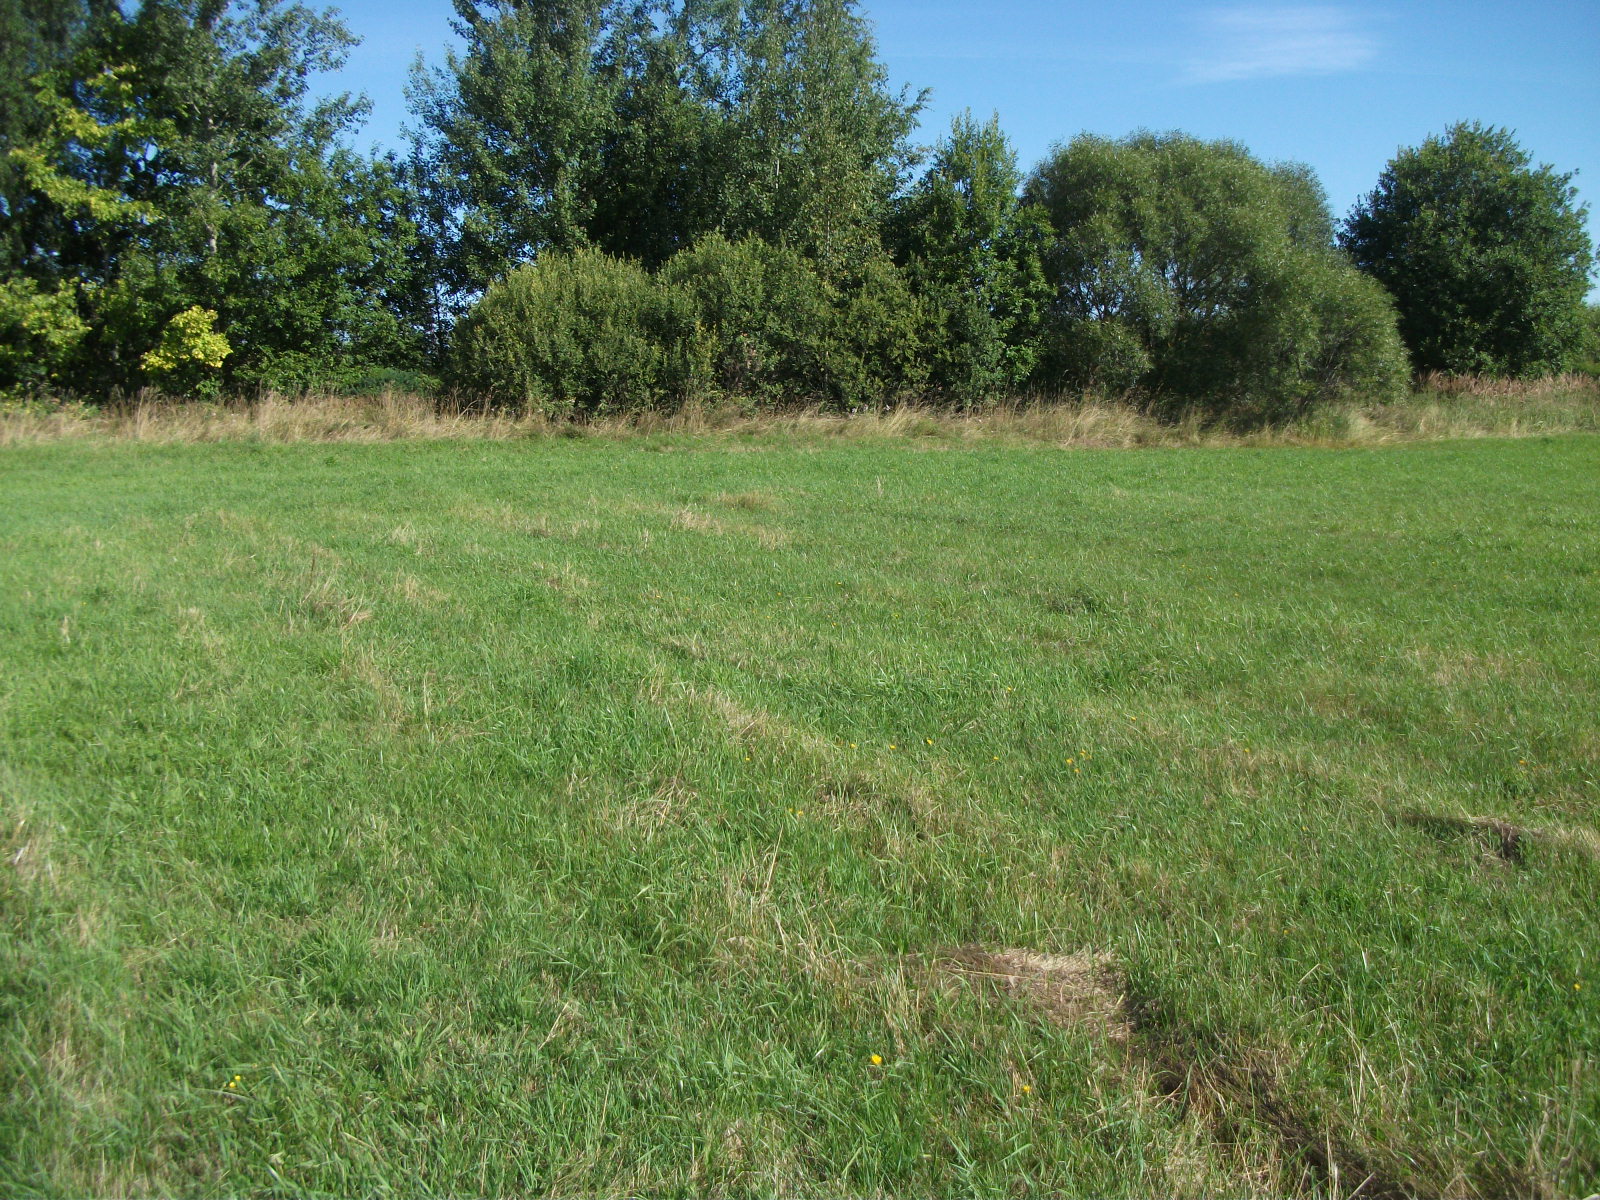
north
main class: Grassland
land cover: Grassland without tree/shrub cover
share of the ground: > 75 %
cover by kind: herbaceous plants 100 %
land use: Agriculture (excluding fallow land and kitchen gardens)
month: August
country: LV
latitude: 56.3304
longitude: 26.2998
